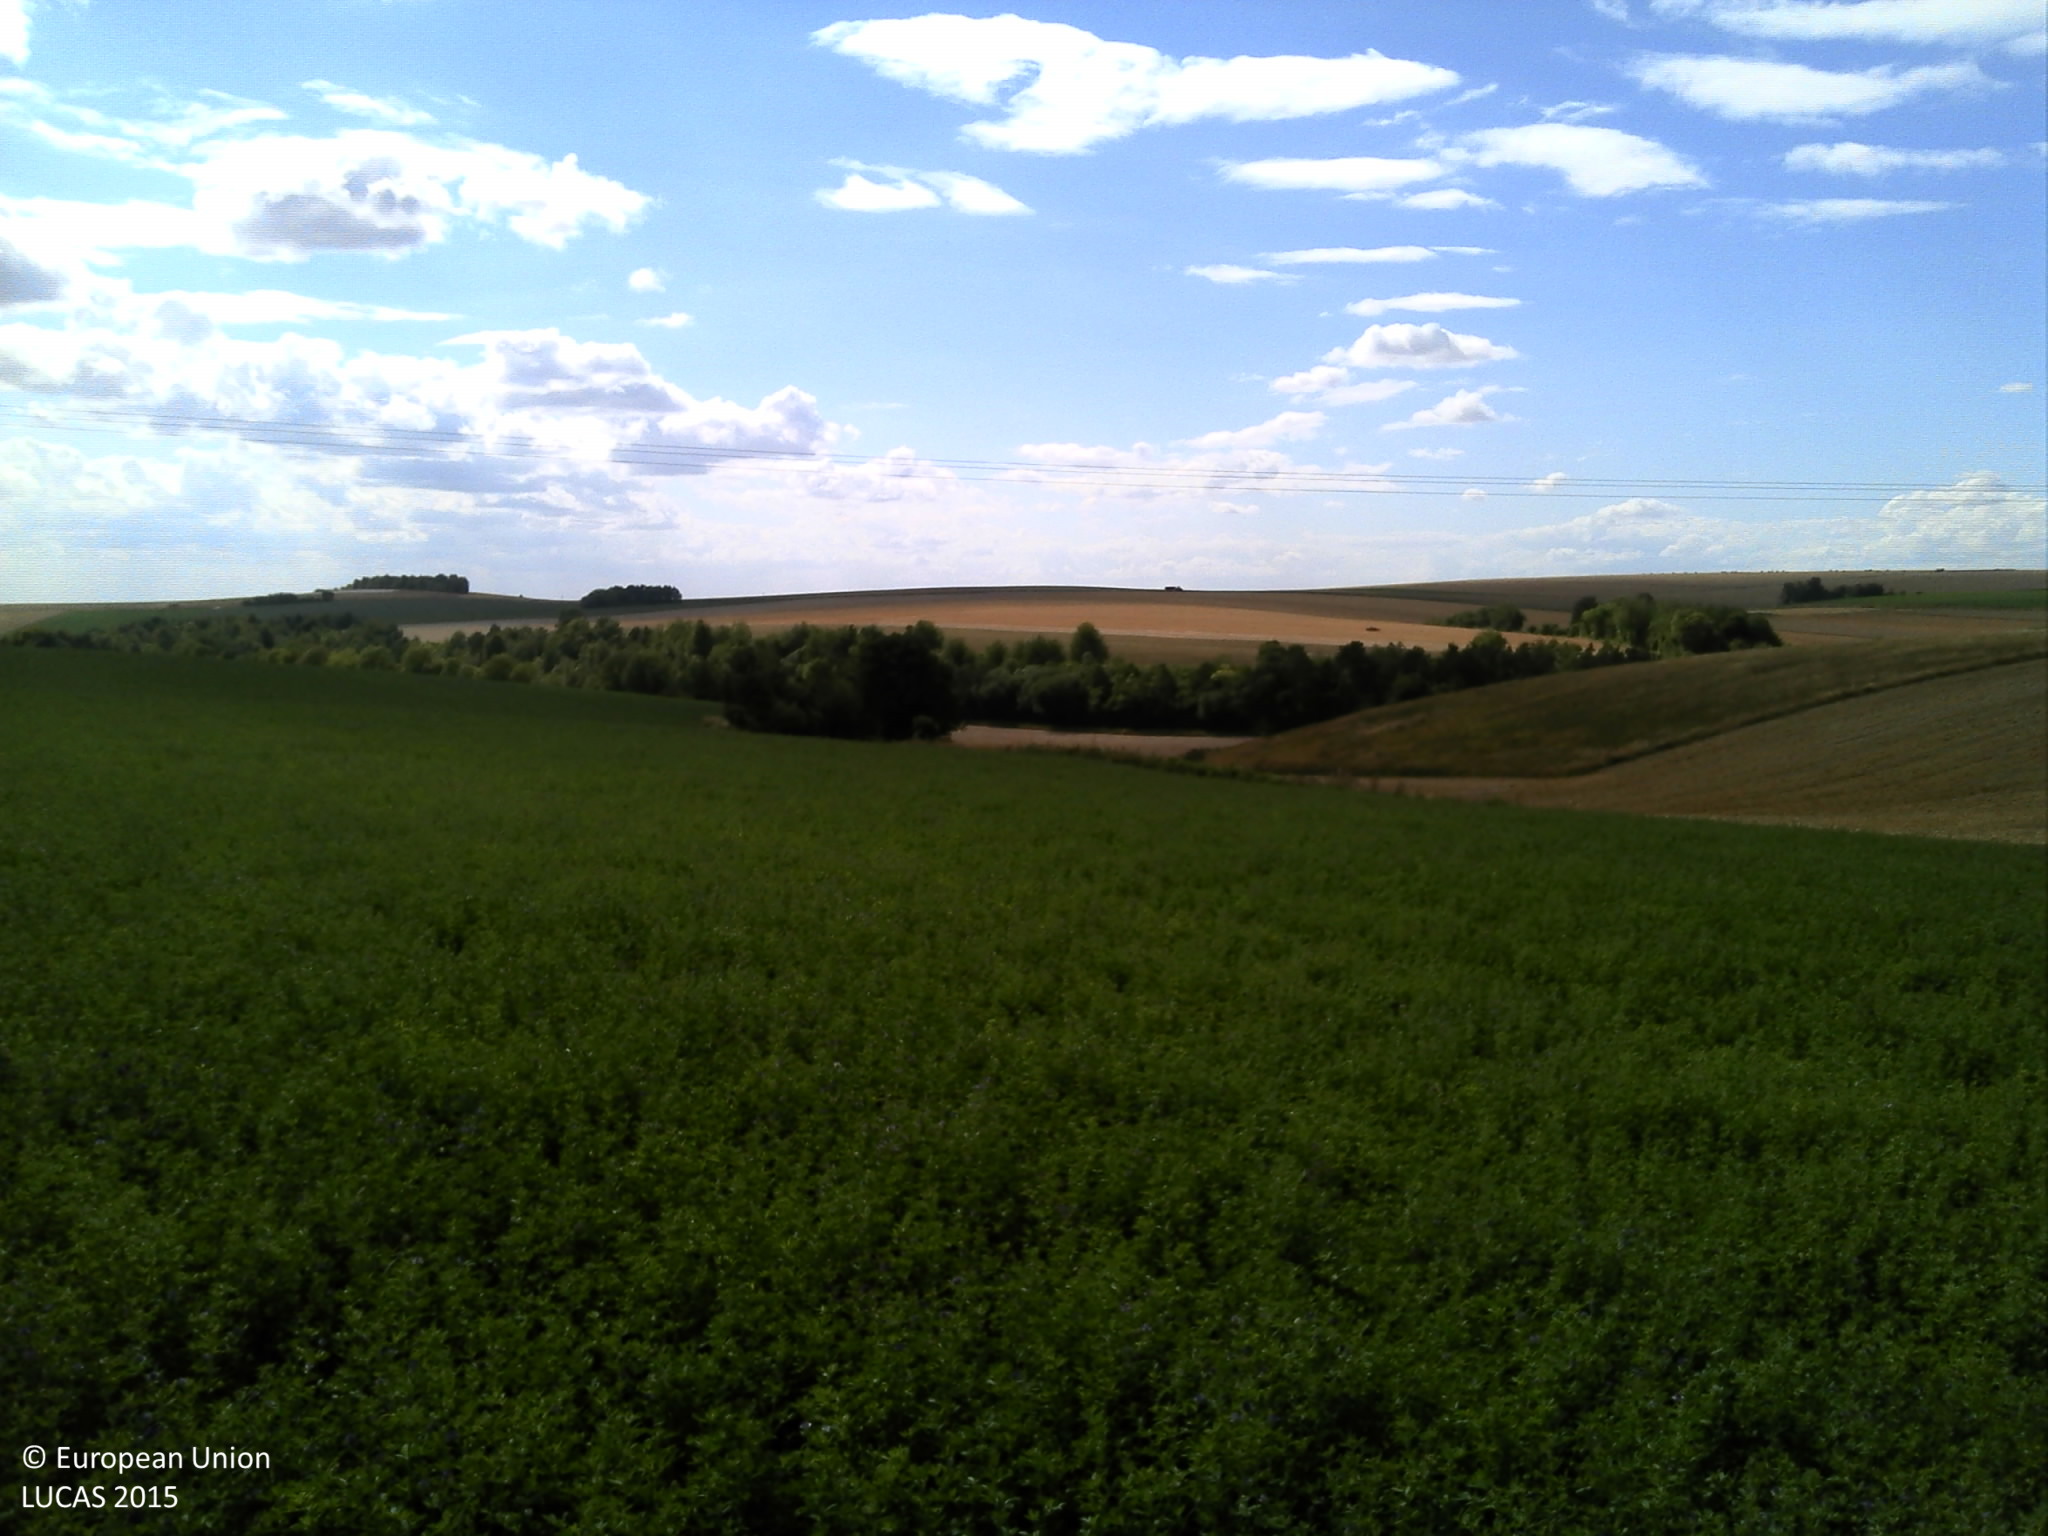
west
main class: Cropland
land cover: Lucerne
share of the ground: > 75 %
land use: Agriculture (excluding fallow land and kitchen gardens)
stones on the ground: < 10 %
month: July
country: FR
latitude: 49.2849
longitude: 4.6765
